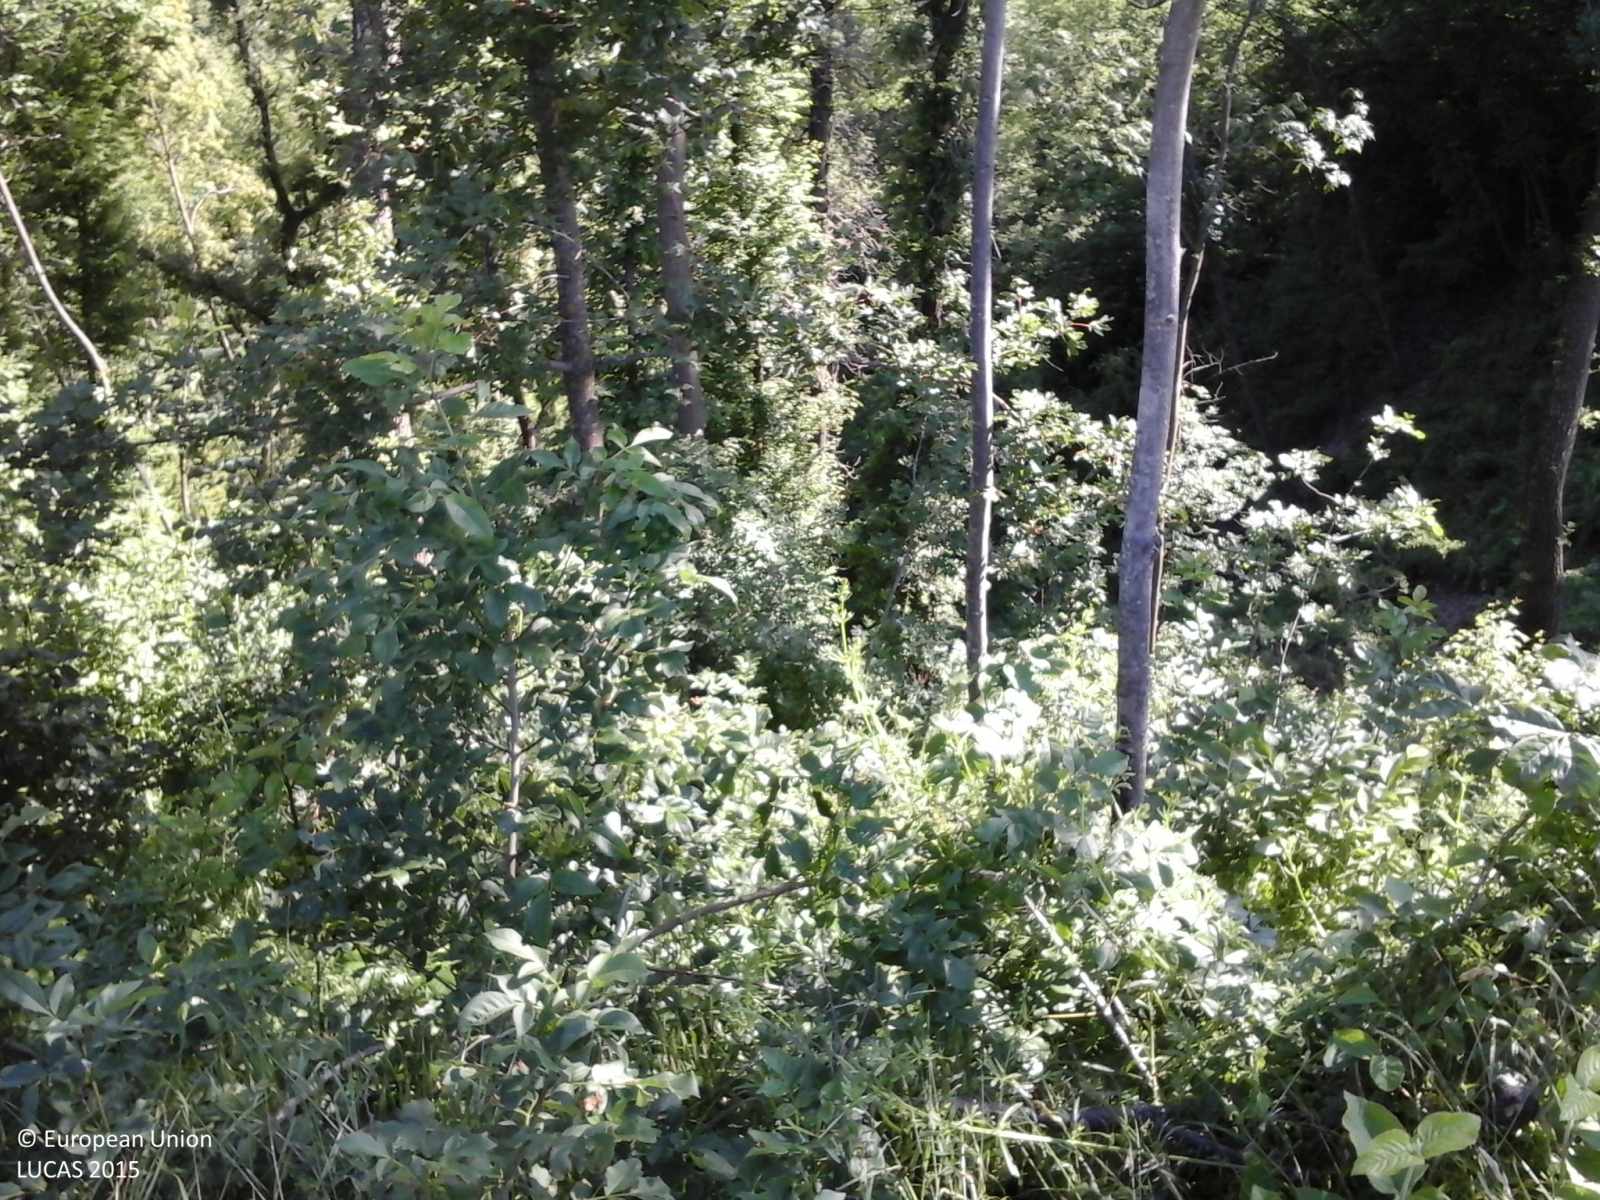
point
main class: Woodland
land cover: Broadleaved woodland
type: thermophilous deciduous forest
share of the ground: > 75 %
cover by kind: broadleaved forest trees 90 %, shrubs 5 %, herbaceous plants 5 %
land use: Forestry
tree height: > 5 m
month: May
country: IT
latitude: 44.4027
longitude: 10.6389
